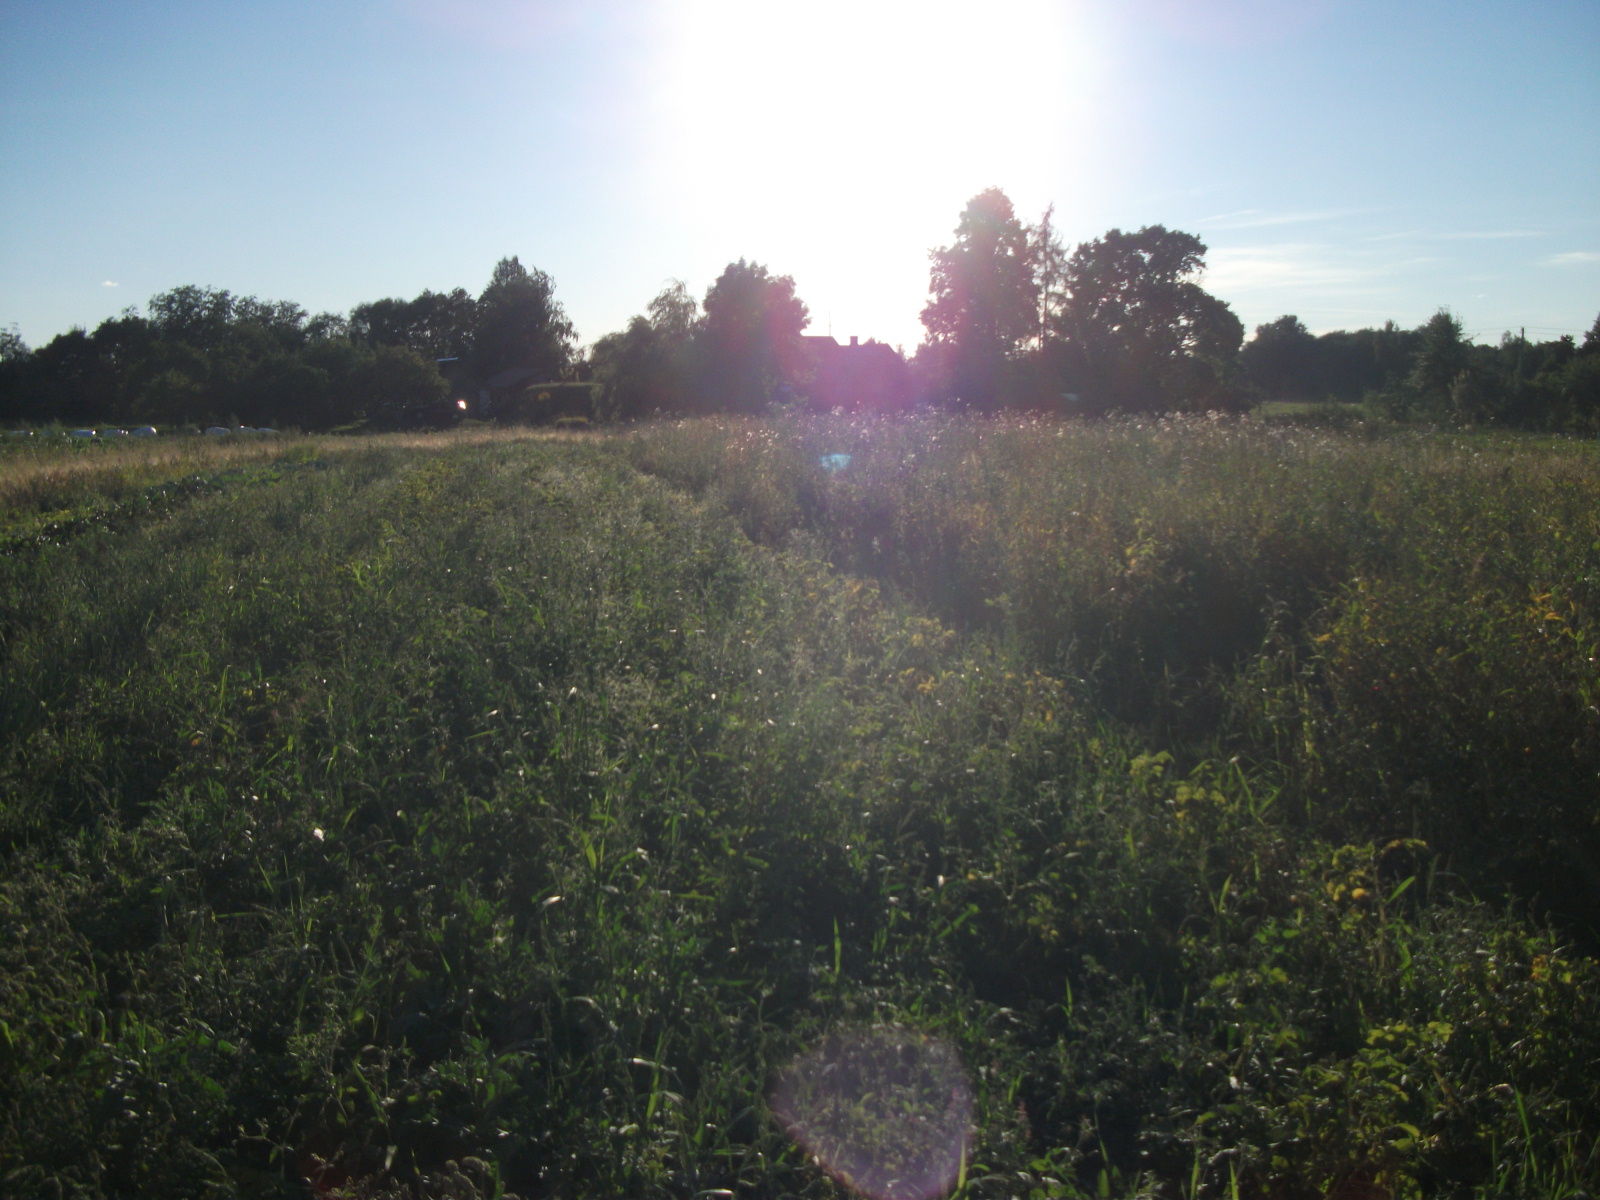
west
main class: Cropland
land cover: Potatoes
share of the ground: > 75 %
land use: Kitchen garden
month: August
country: LV
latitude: 56.5396
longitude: 26.3905
